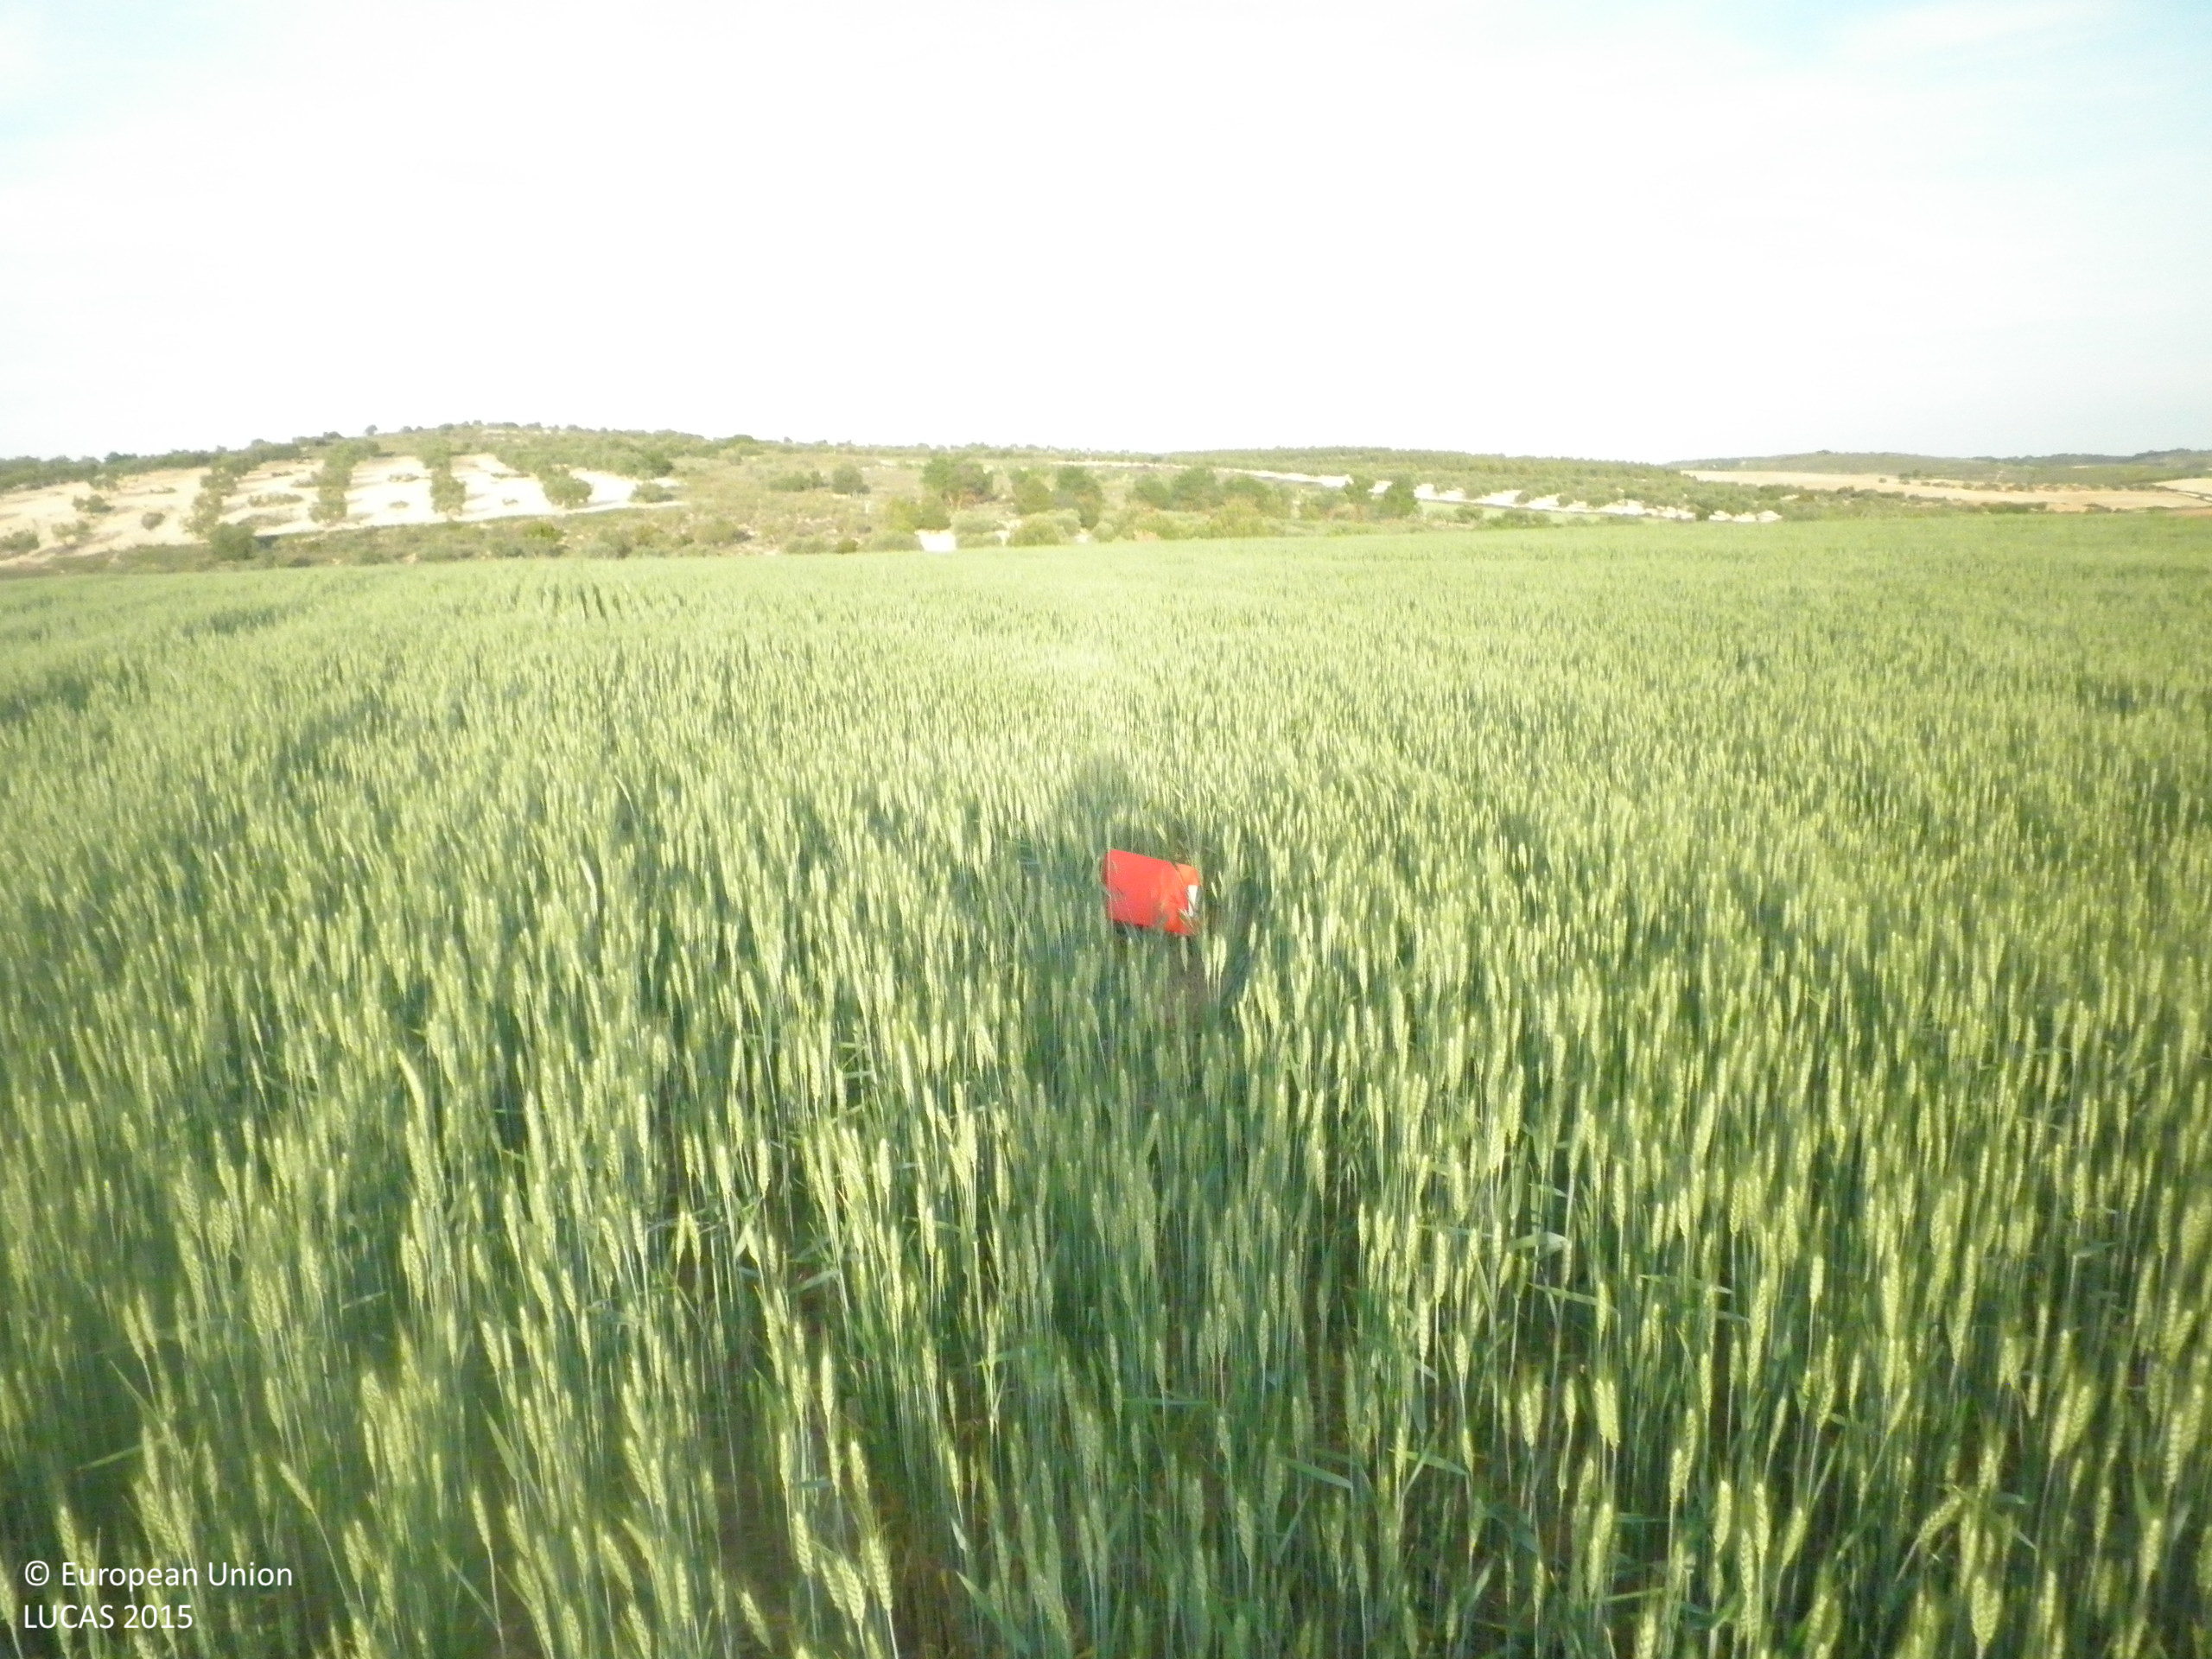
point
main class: Cropland
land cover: Durum wheat
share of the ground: > 75 %
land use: Agriculture (excluding fallow land and kitchen gardens)
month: May
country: ES
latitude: 39.6033
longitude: -2.6980
